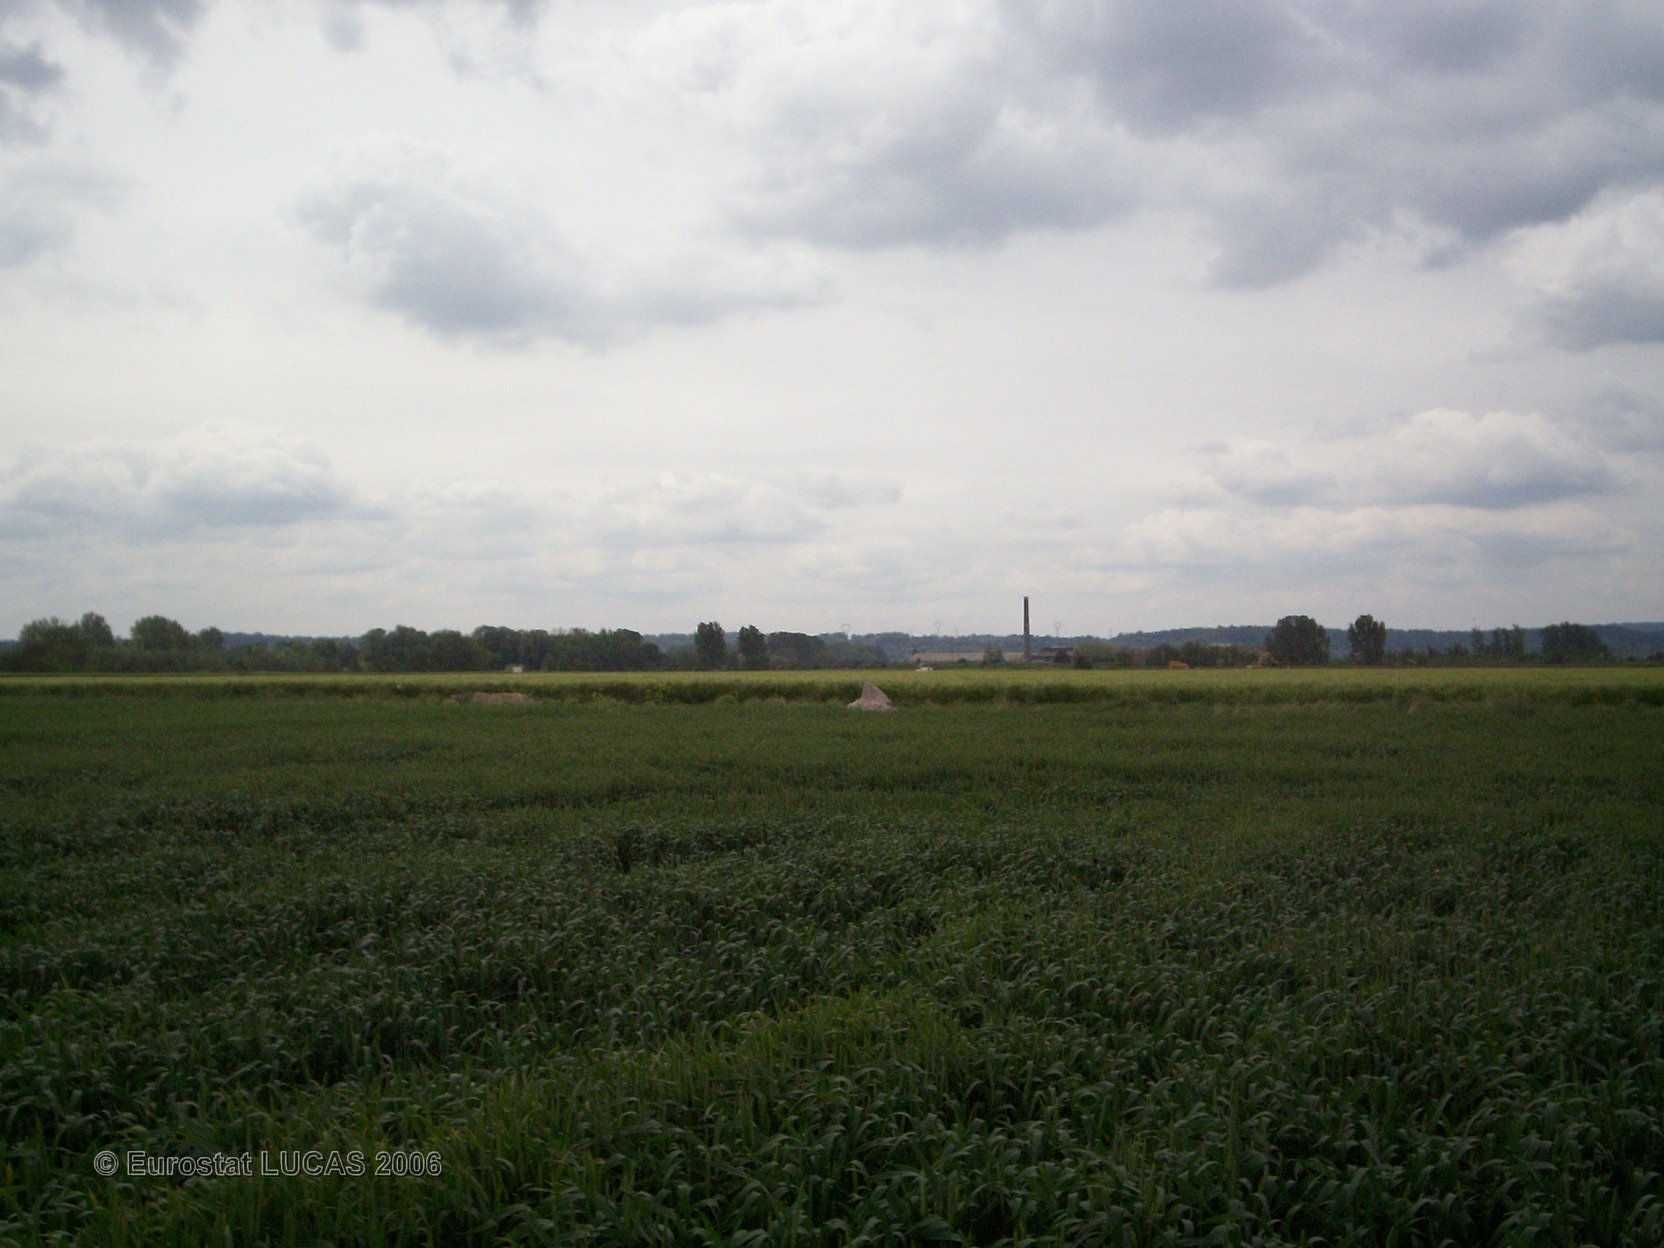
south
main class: Cropland
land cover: Common wheat
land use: Agriculture (excluding fallow land and kitchen gardens)
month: June
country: FR
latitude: 49.3385
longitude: 2.7365
